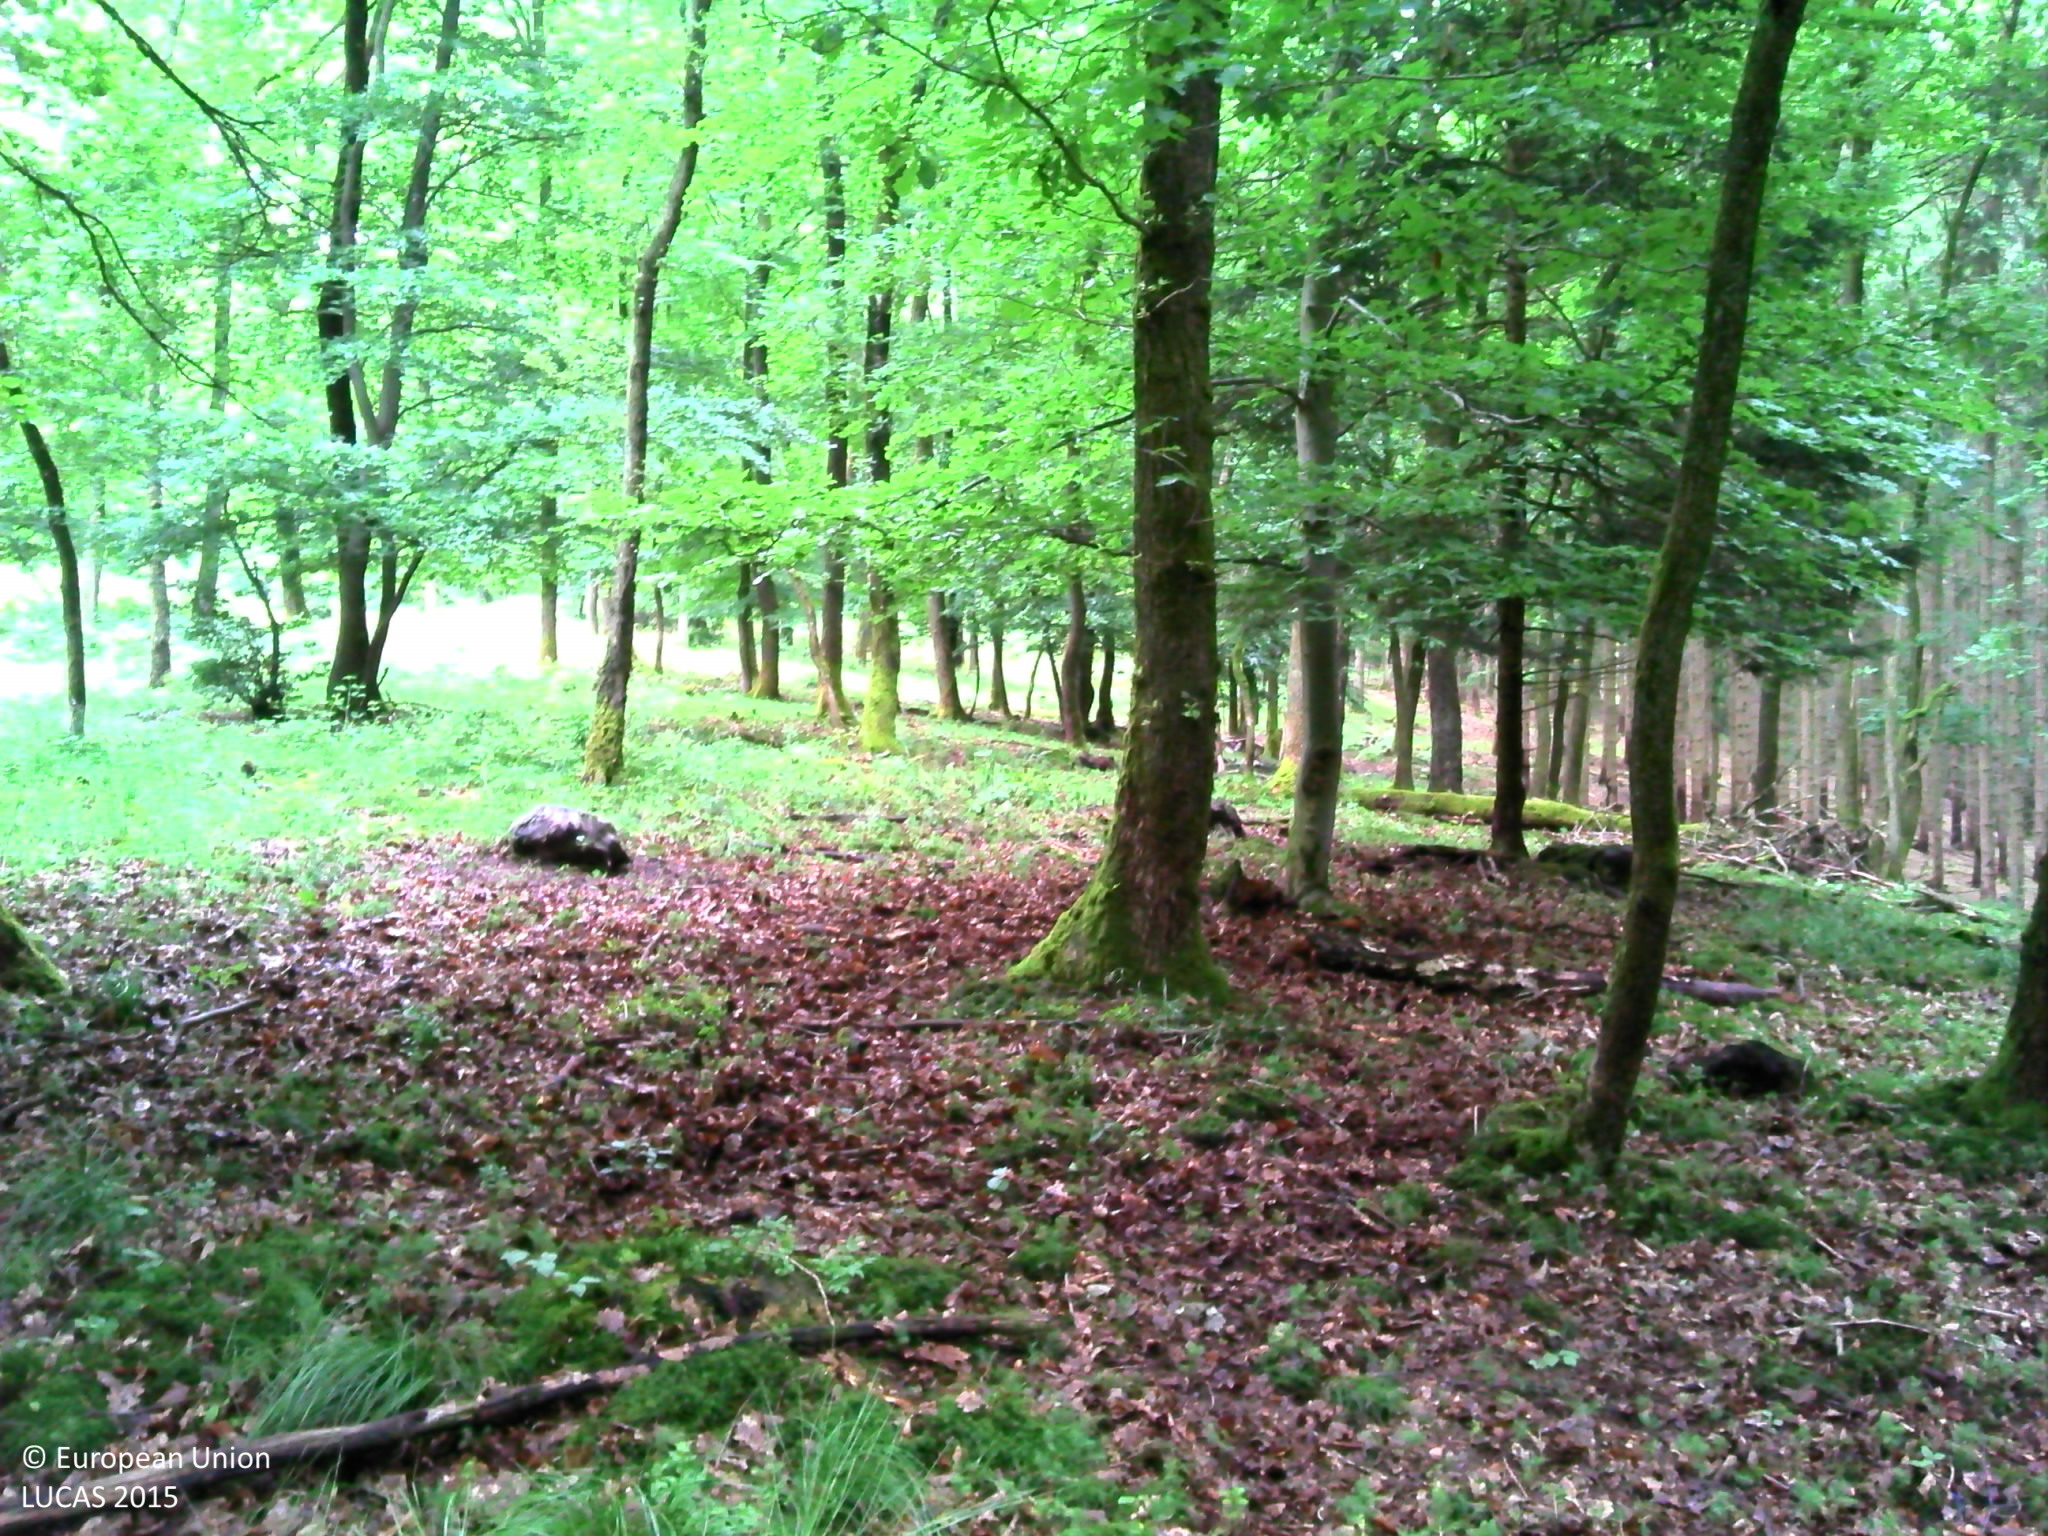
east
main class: Woodland
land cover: Broadleaved woodland
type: acidophilous oak and oak-birch forest
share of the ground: > 75 %
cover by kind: broadleaved forest trees 85 %, coniferous forest trees 5 %, herbaceous plants 5 %, lichens and mosses 5 %
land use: Forestry
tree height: > 5 m
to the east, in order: Broadleaved woodland; Tracks; Broadleaved woodland; Spontaneously vegetated surfaces; Grassland without tree/shrub cover
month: June
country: BE
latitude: 50.3335
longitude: 5.6011
